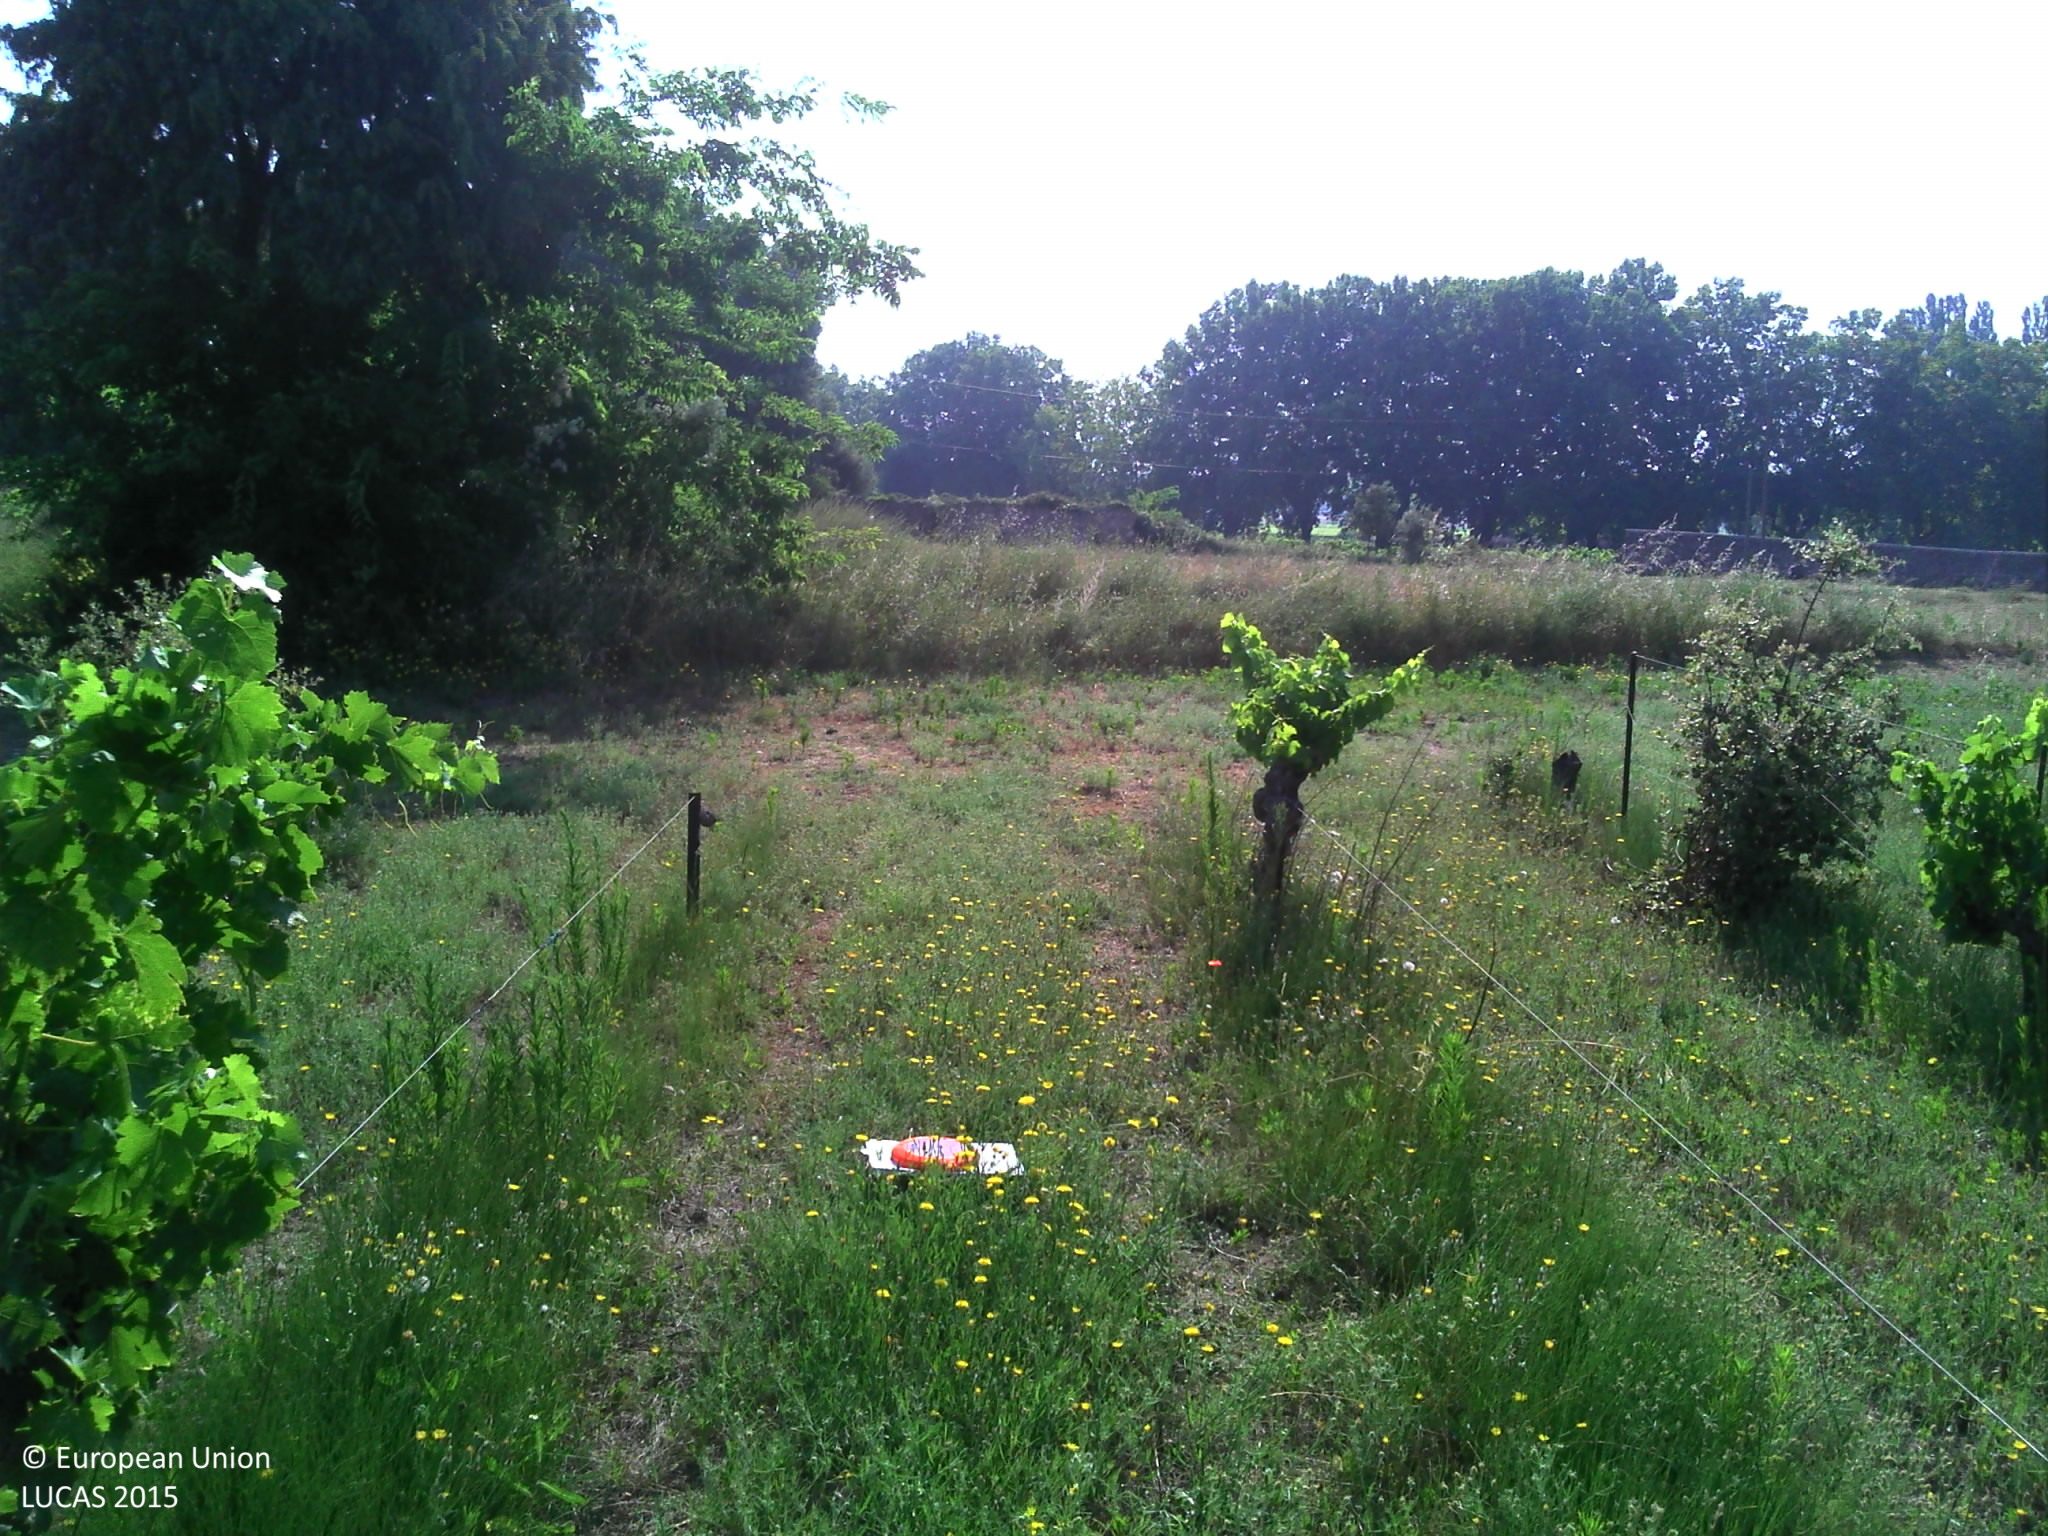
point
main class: Cropland
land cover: Vineyards
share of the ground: 25 - 50 %
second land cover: Grassland without tree/shrub cover
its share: 50 - 75 %
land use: Agriculture (excluding fallow land and kitchen gardens)
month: July
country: FR
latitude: 44.3095
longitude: 4.7798
